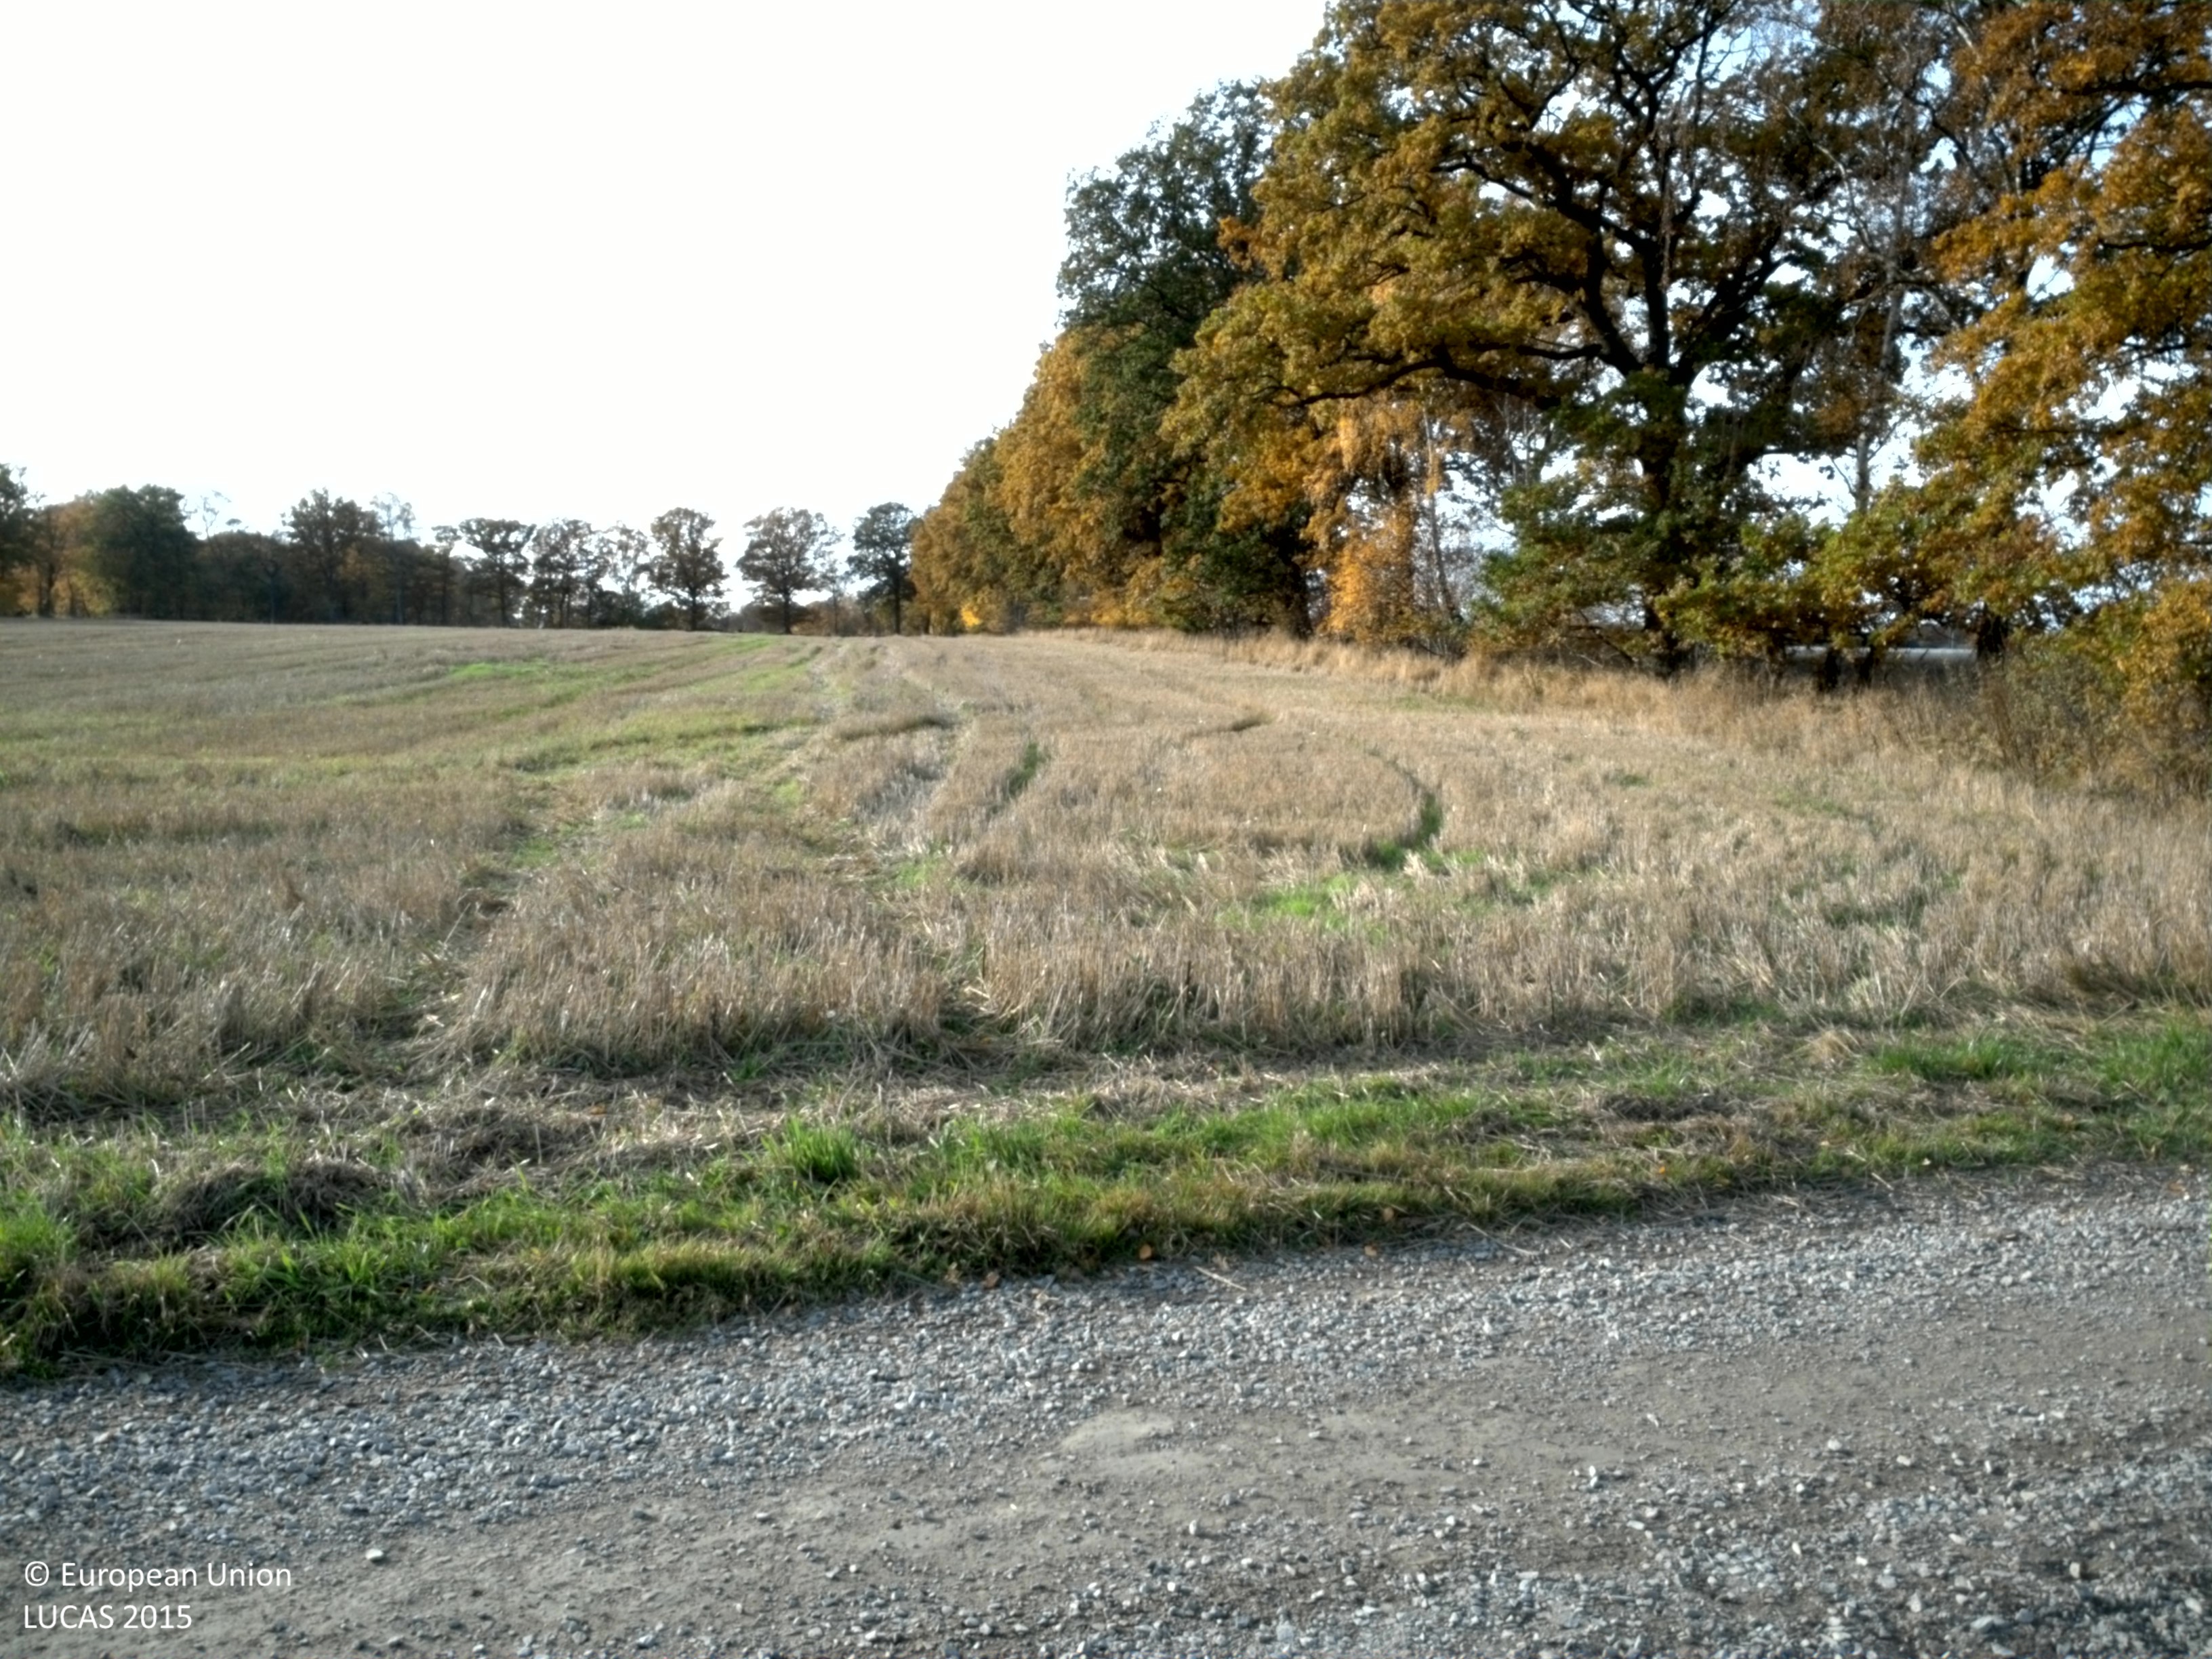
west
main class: Cropland
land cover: Common wheat
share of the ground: < 10 %
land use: Agriculture (excluding fallow land and kitchen gardens)
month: October
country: SE
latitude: 56.0305
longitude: 12.8380
